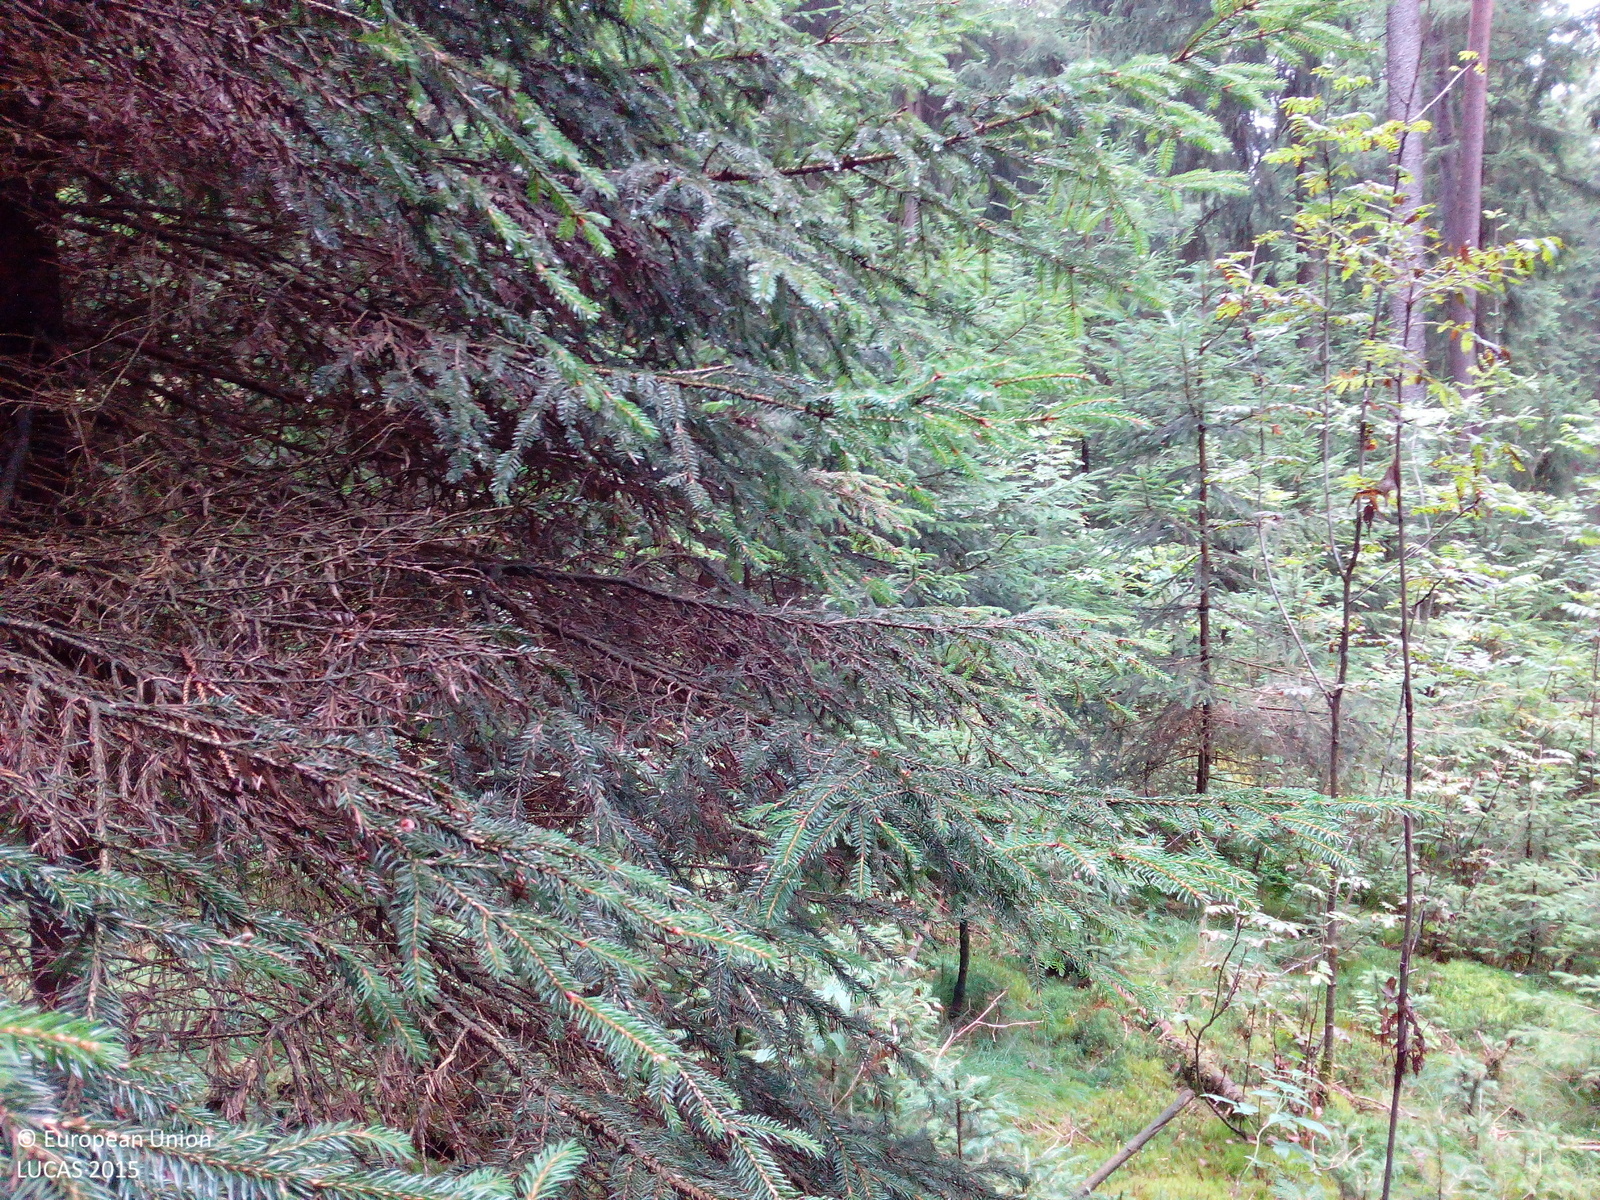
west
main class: Woodland
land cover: Spruce dominated coniferous woodland
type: boreal forest
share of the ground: > 75 %
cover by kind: coniferous forest trees 95 %, lichens and mosses 5 %
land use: Forestry
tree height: > 5 m
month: August
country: DE
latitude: 50.3343
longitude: 11.6433
